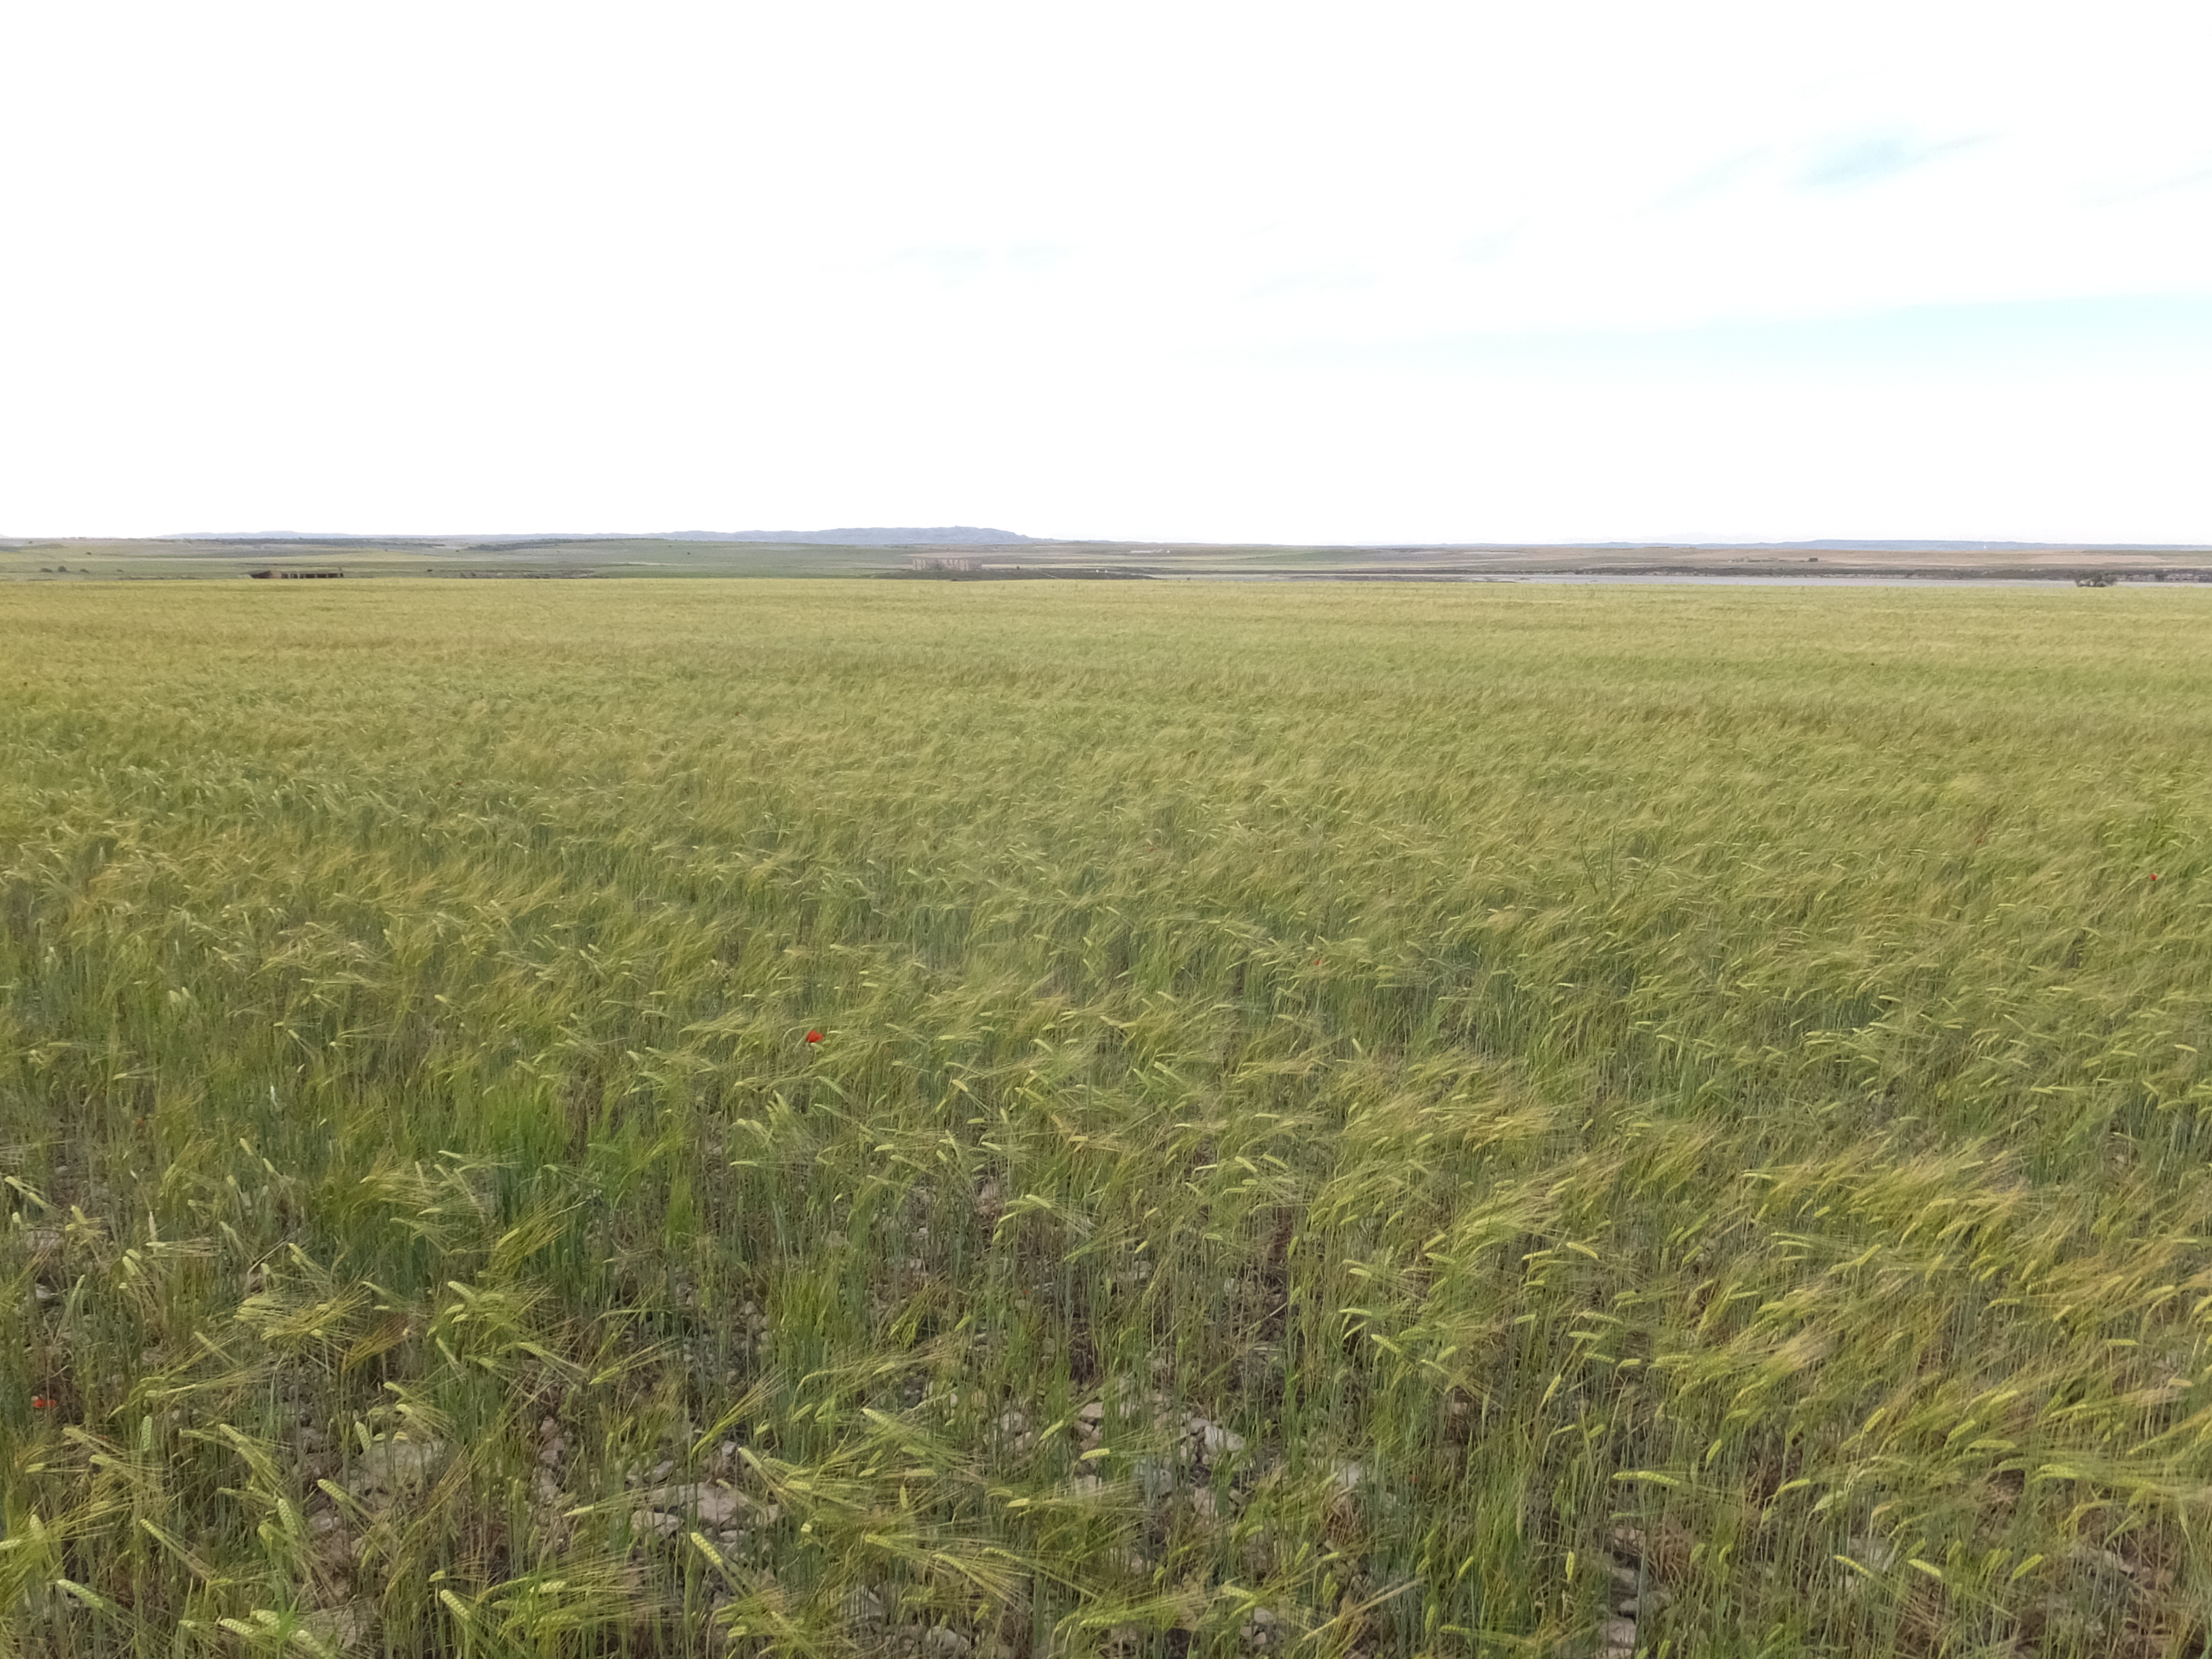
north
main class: Cropland
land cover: Barley
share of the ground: > 75 %
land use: Agriculture (excluding fallow land and kitchen gardens)
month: May
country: ES
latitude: 41.4104
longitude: -0.1955
